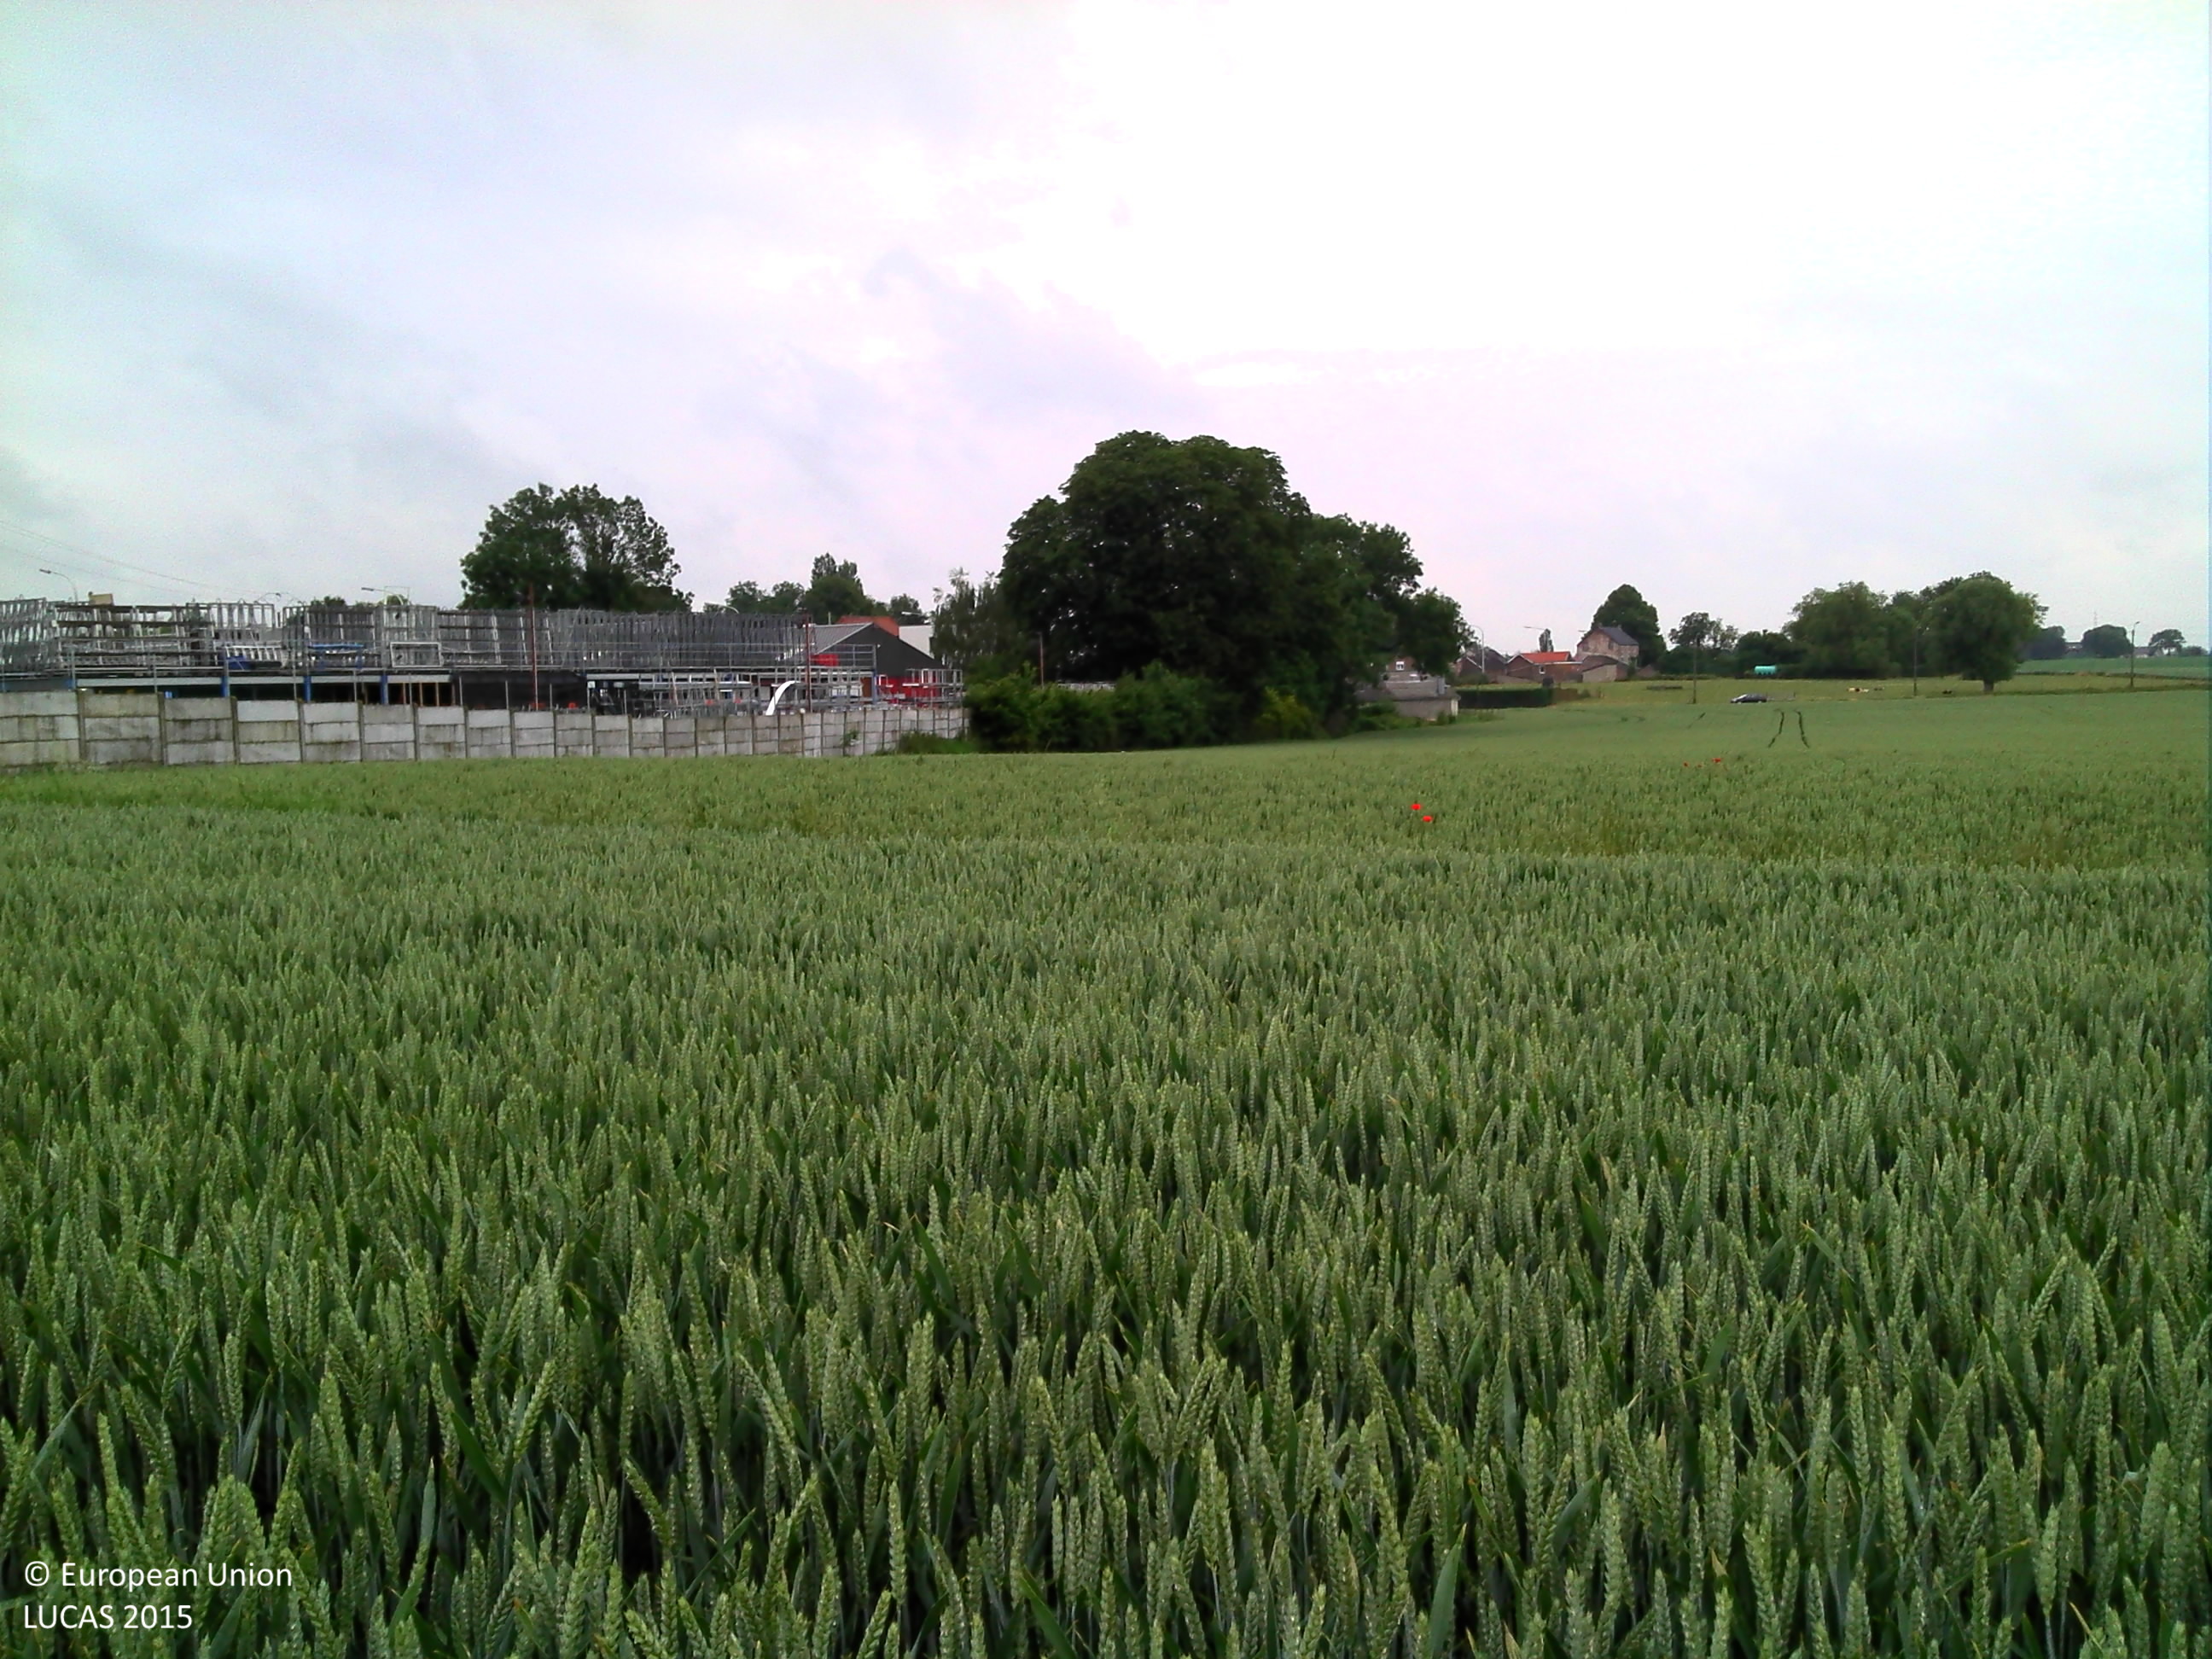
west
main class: Cropland
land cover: Common wheat
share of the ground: > 75 %
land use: Agriculture (excluding fallow land and kitchen gardens)
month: June
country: BE
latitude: 50.6880
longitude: 5.4544
